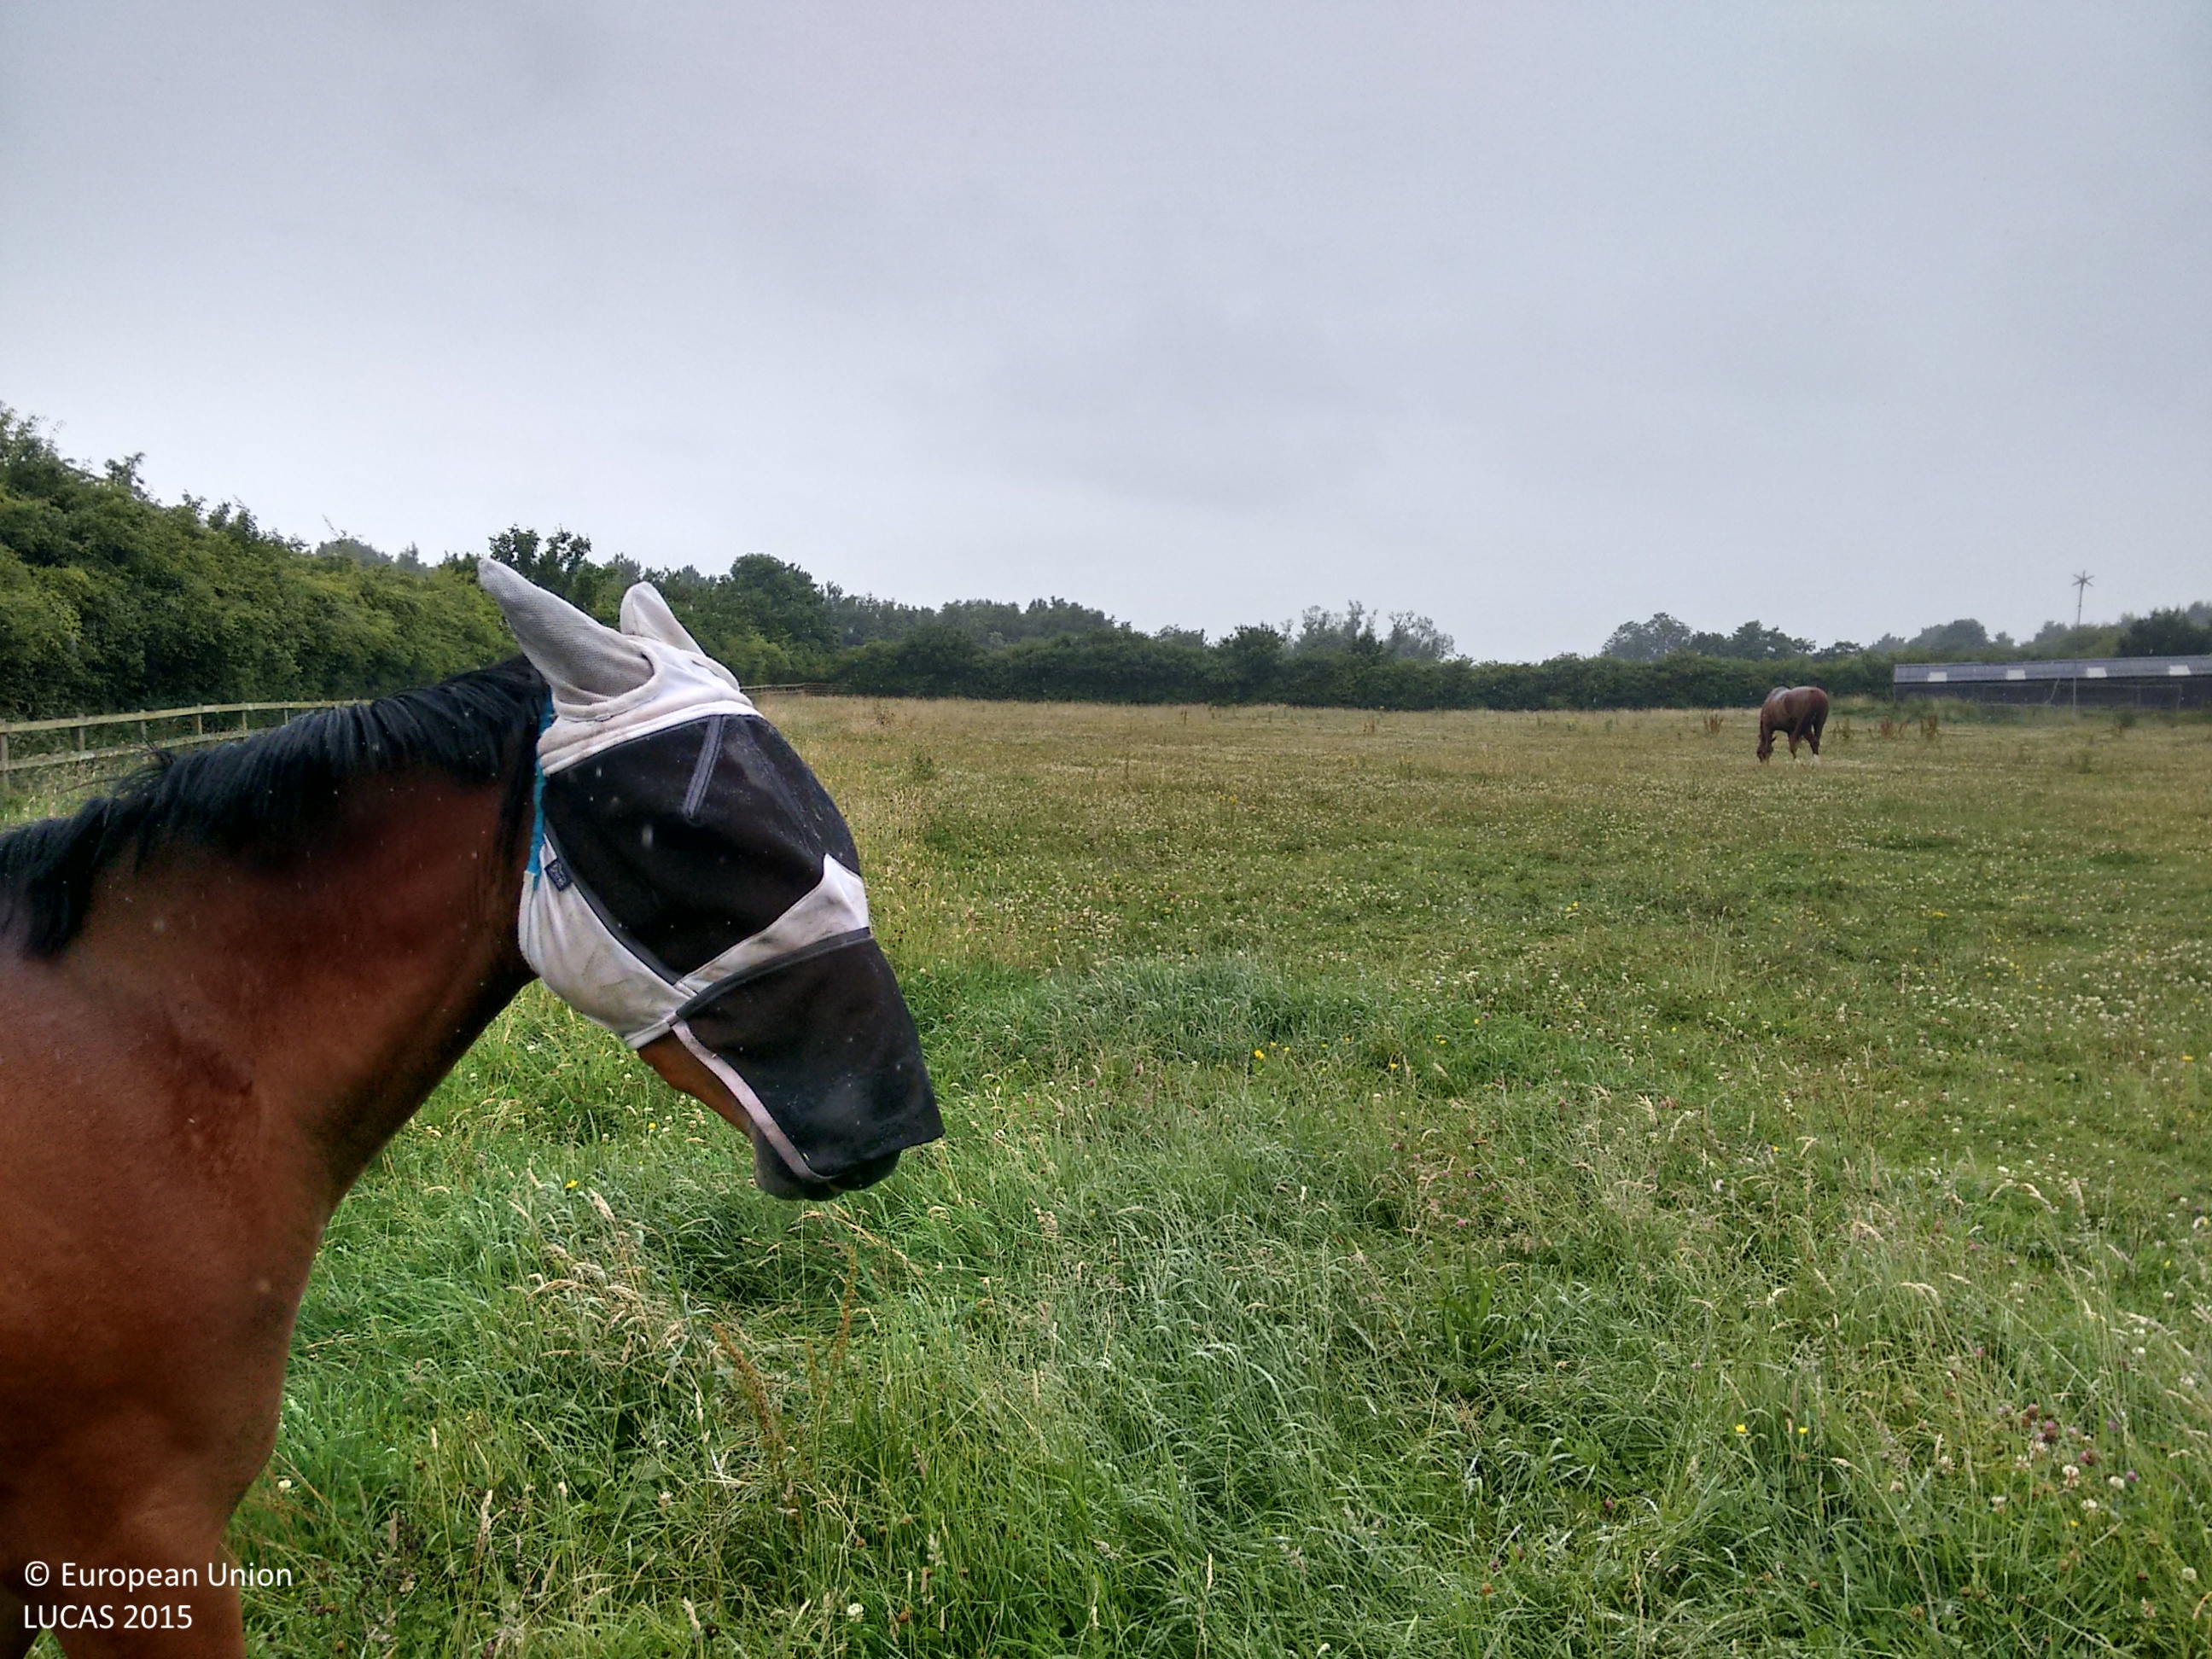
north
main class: Grassland
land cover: Grassland without tree/shrub cover
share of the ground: > 75 %
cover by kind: herbaceous plants 100 %
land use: Agriculture (excluding fallow land and kitchen gardens)
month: July
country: GB
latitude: 53.0665
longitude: -1.3455
